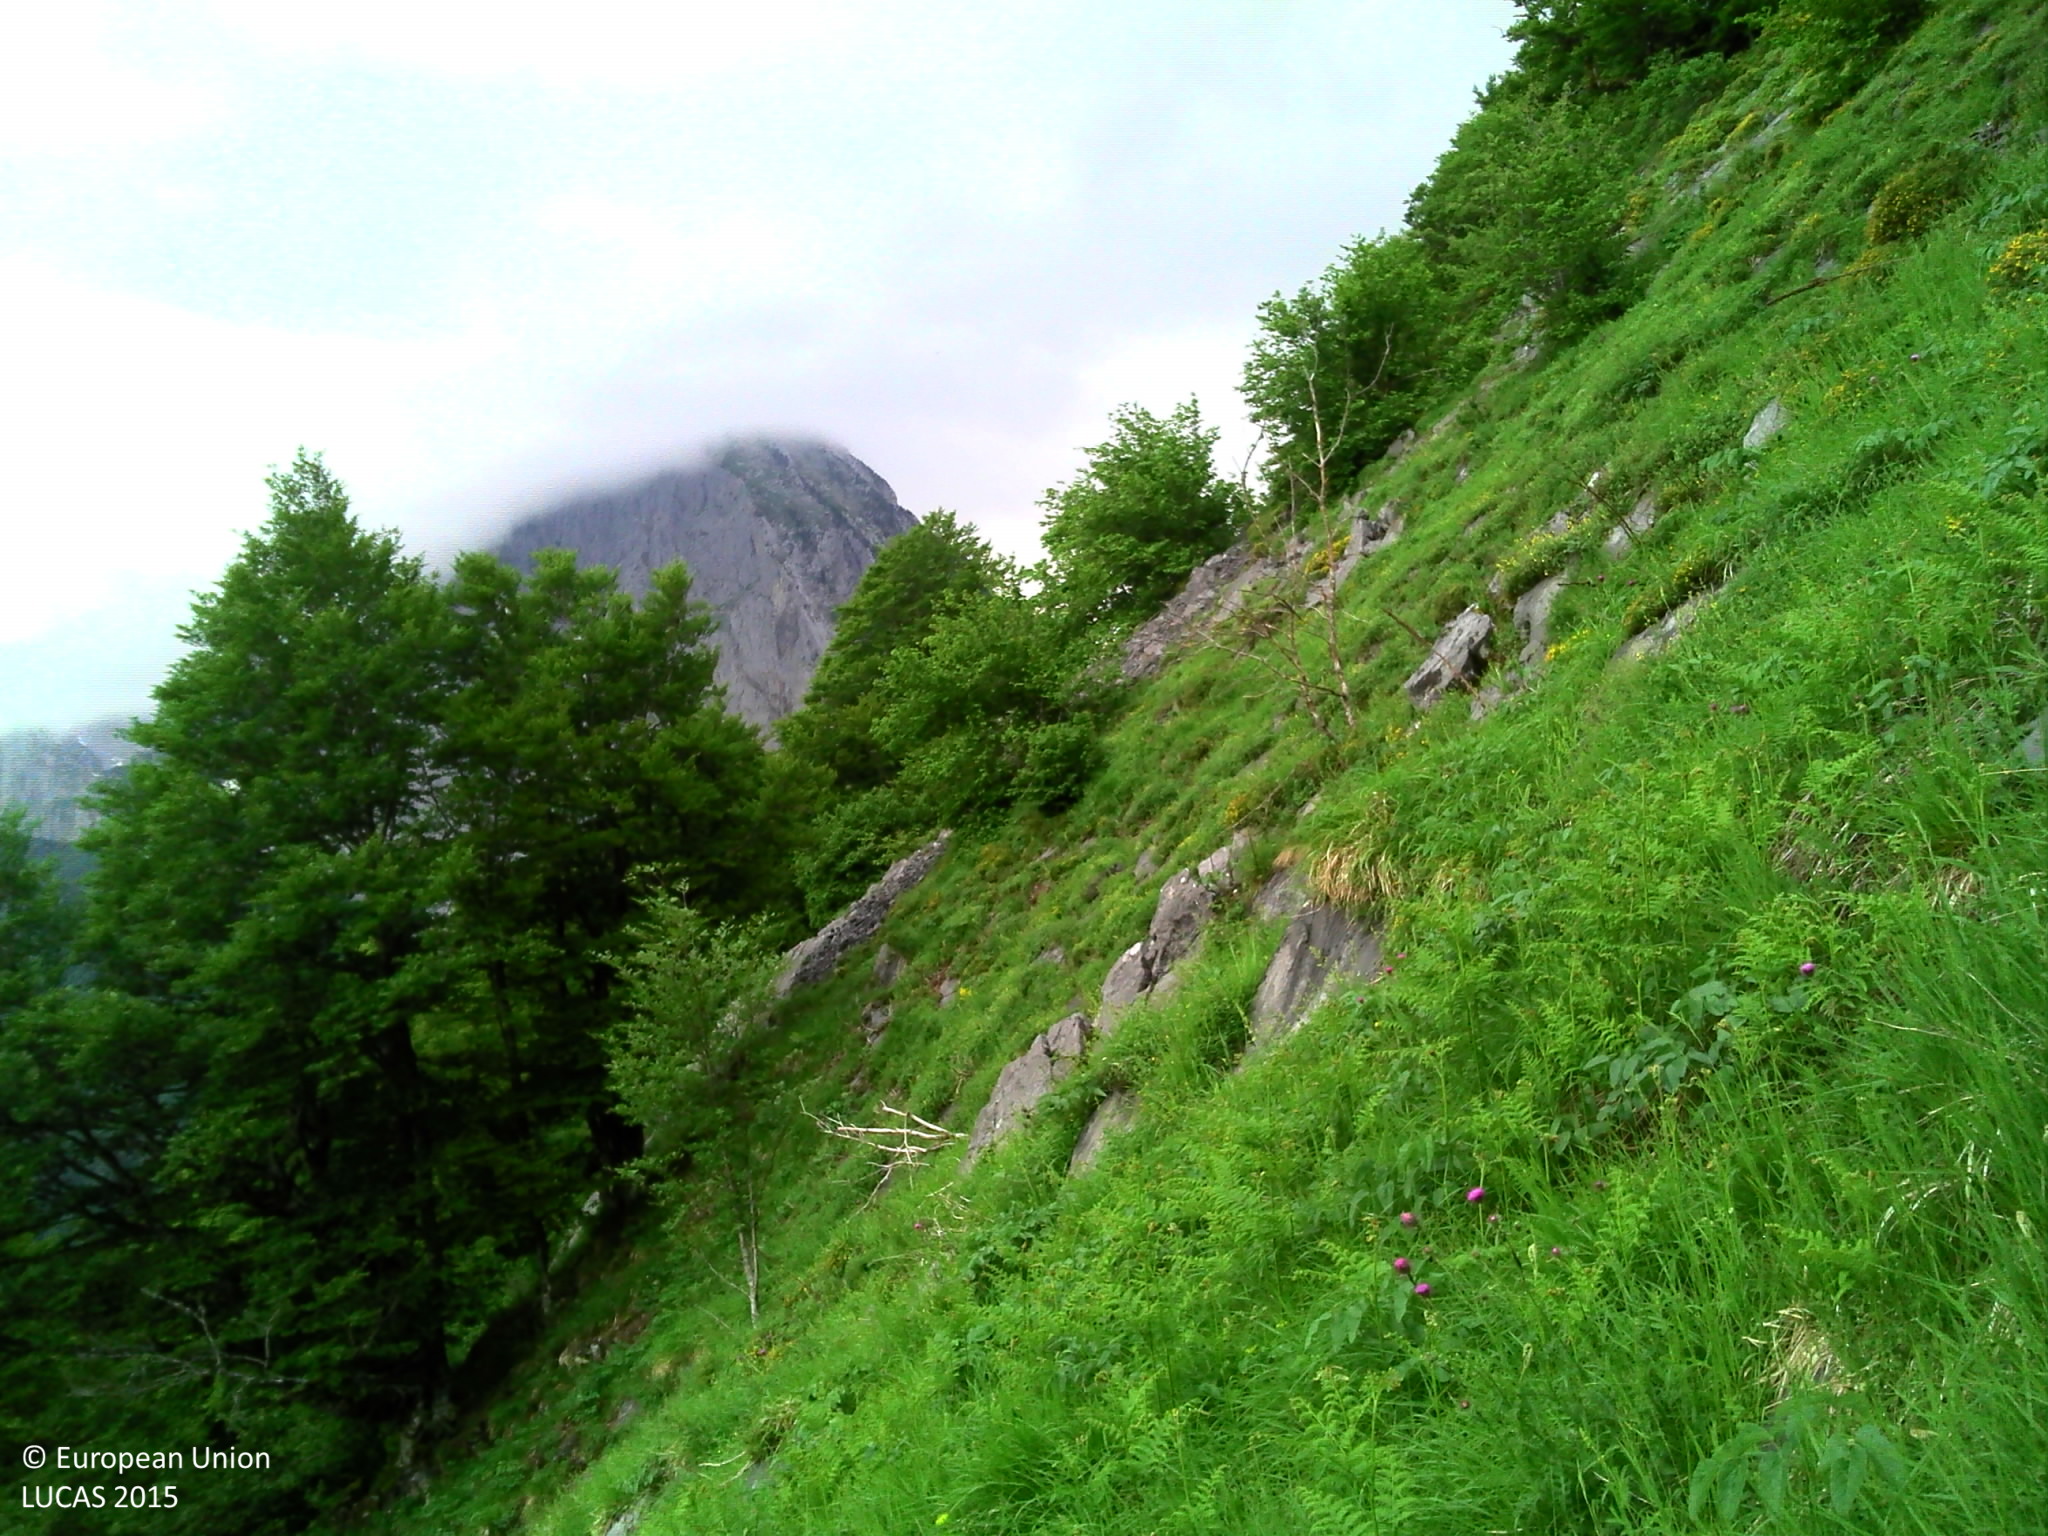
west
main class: Grassland
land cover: Grassland with sparse tree/shrub cover
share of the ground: > 75 %
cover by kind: herbaceous plants 85 %, shrubs 10 %, broadleaved forest trees 5 %
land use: Agriculture (excluding fallow land and kitchen gardens)
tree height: > 5 m
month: June
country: FR
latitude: 42.9455
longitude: -0.6569
